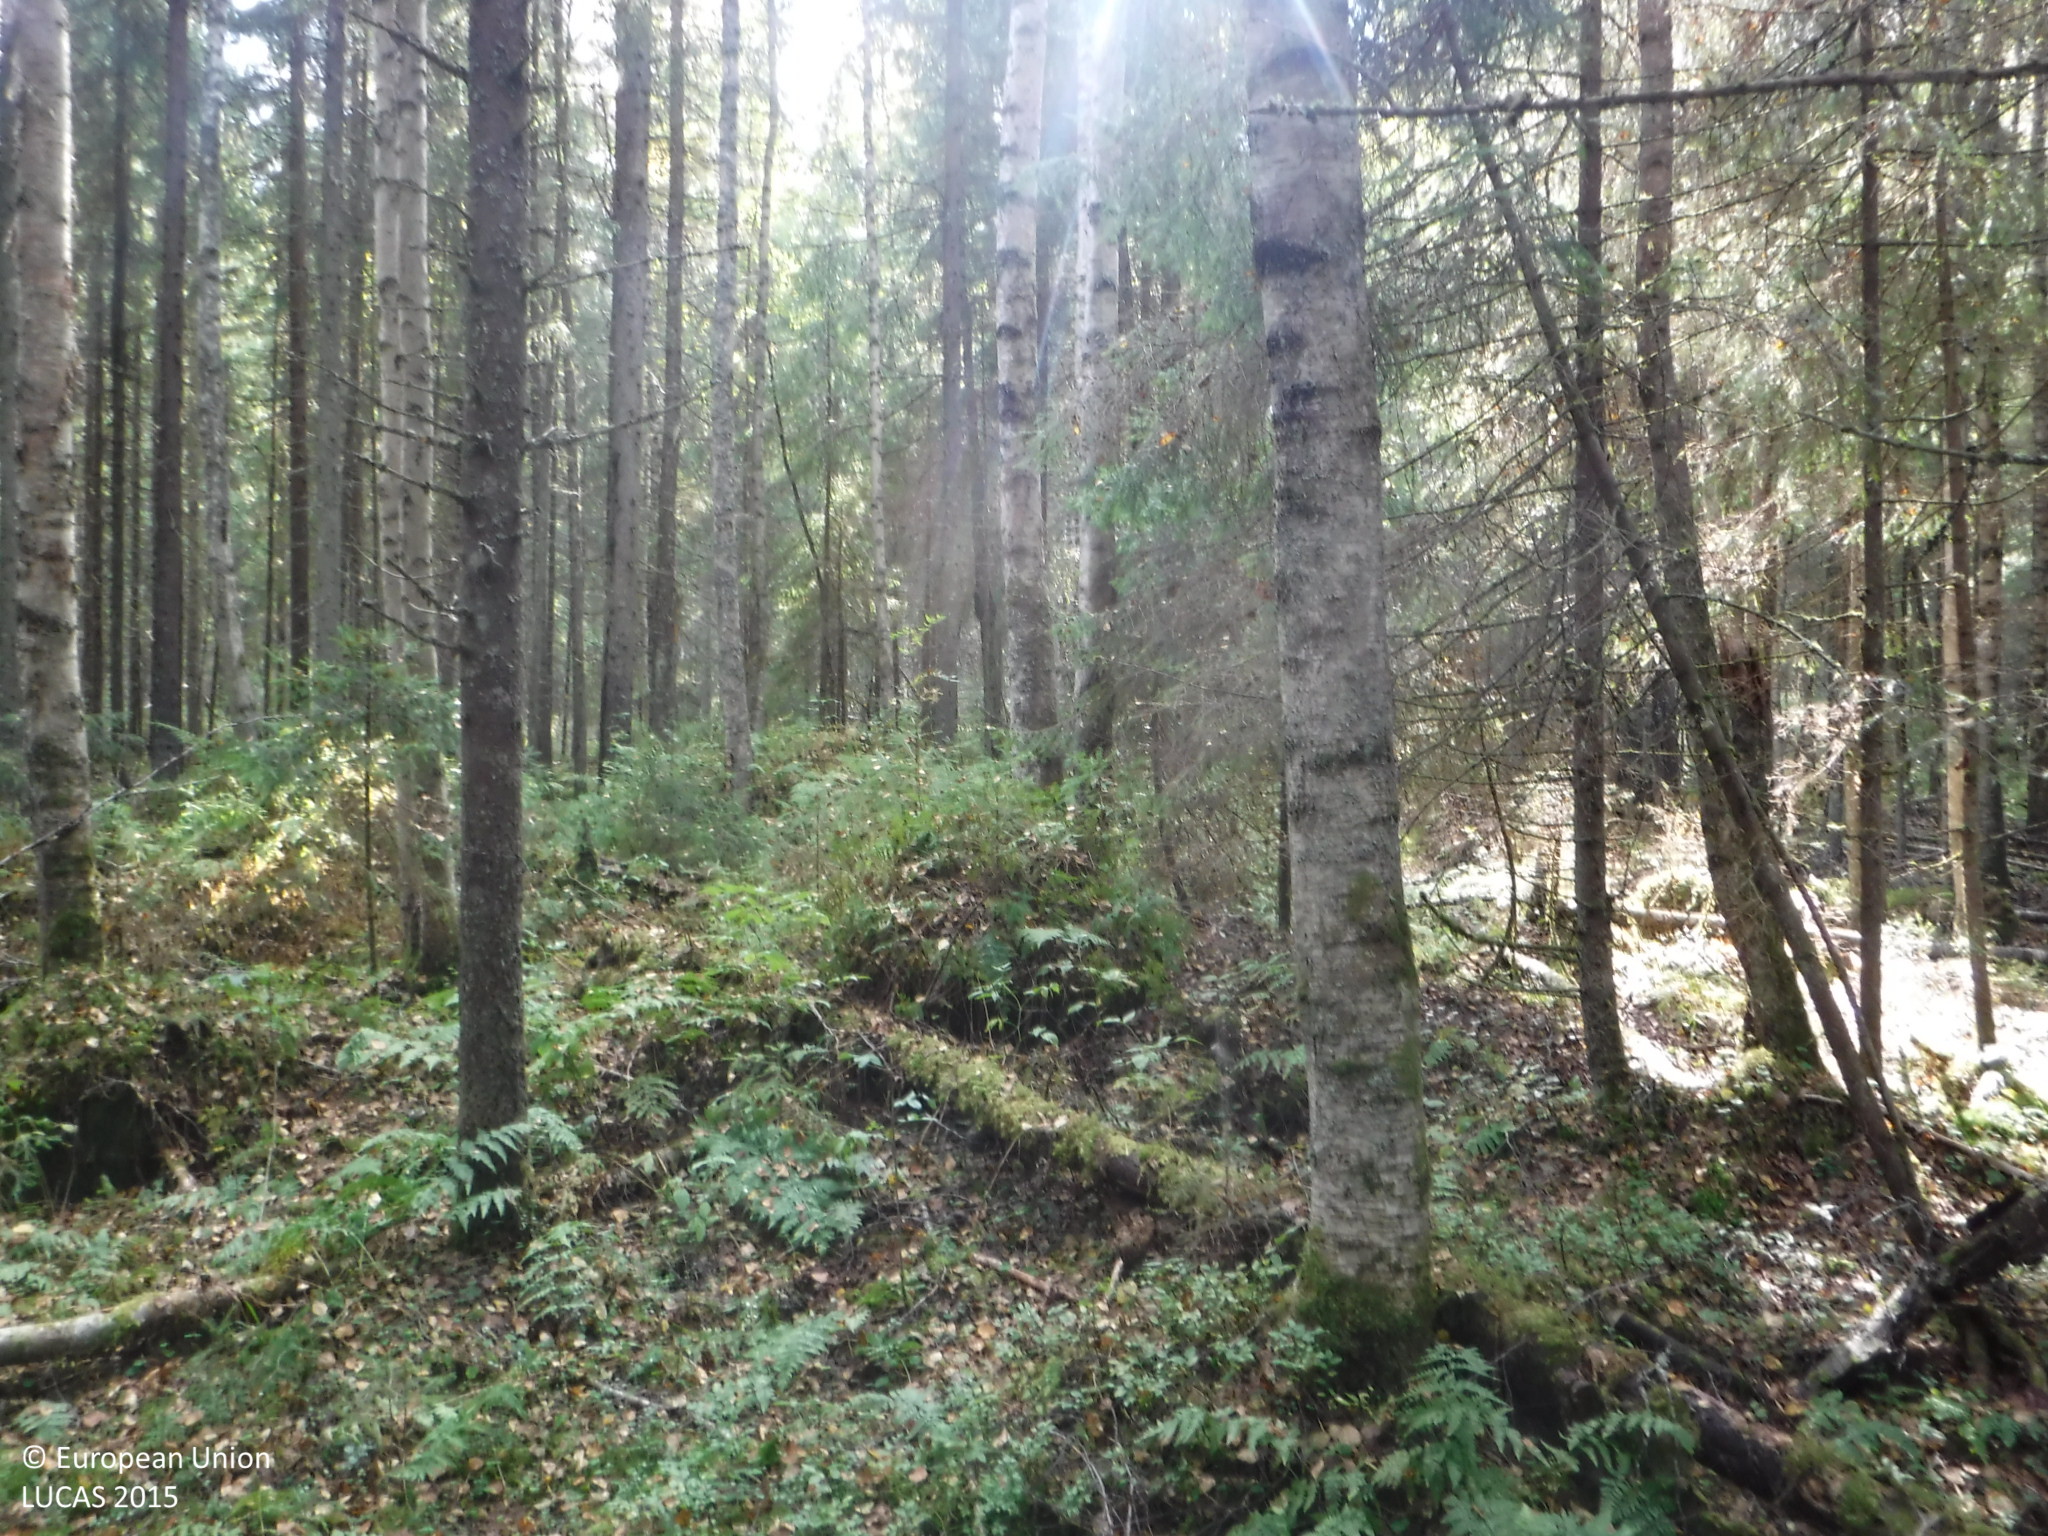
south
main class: Woodland
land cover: Spruce dominated mixed woodland
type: boreal forest
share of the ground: > 75 %
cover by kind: coniferous forest trees 45 %, broadleaved forest trees 30 %, herbaceous plants 15 %, lichens and mosses 10 %
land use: Forestry
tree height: > 5 m
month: September
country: FI
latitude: 61.6979
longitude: 22.3685
